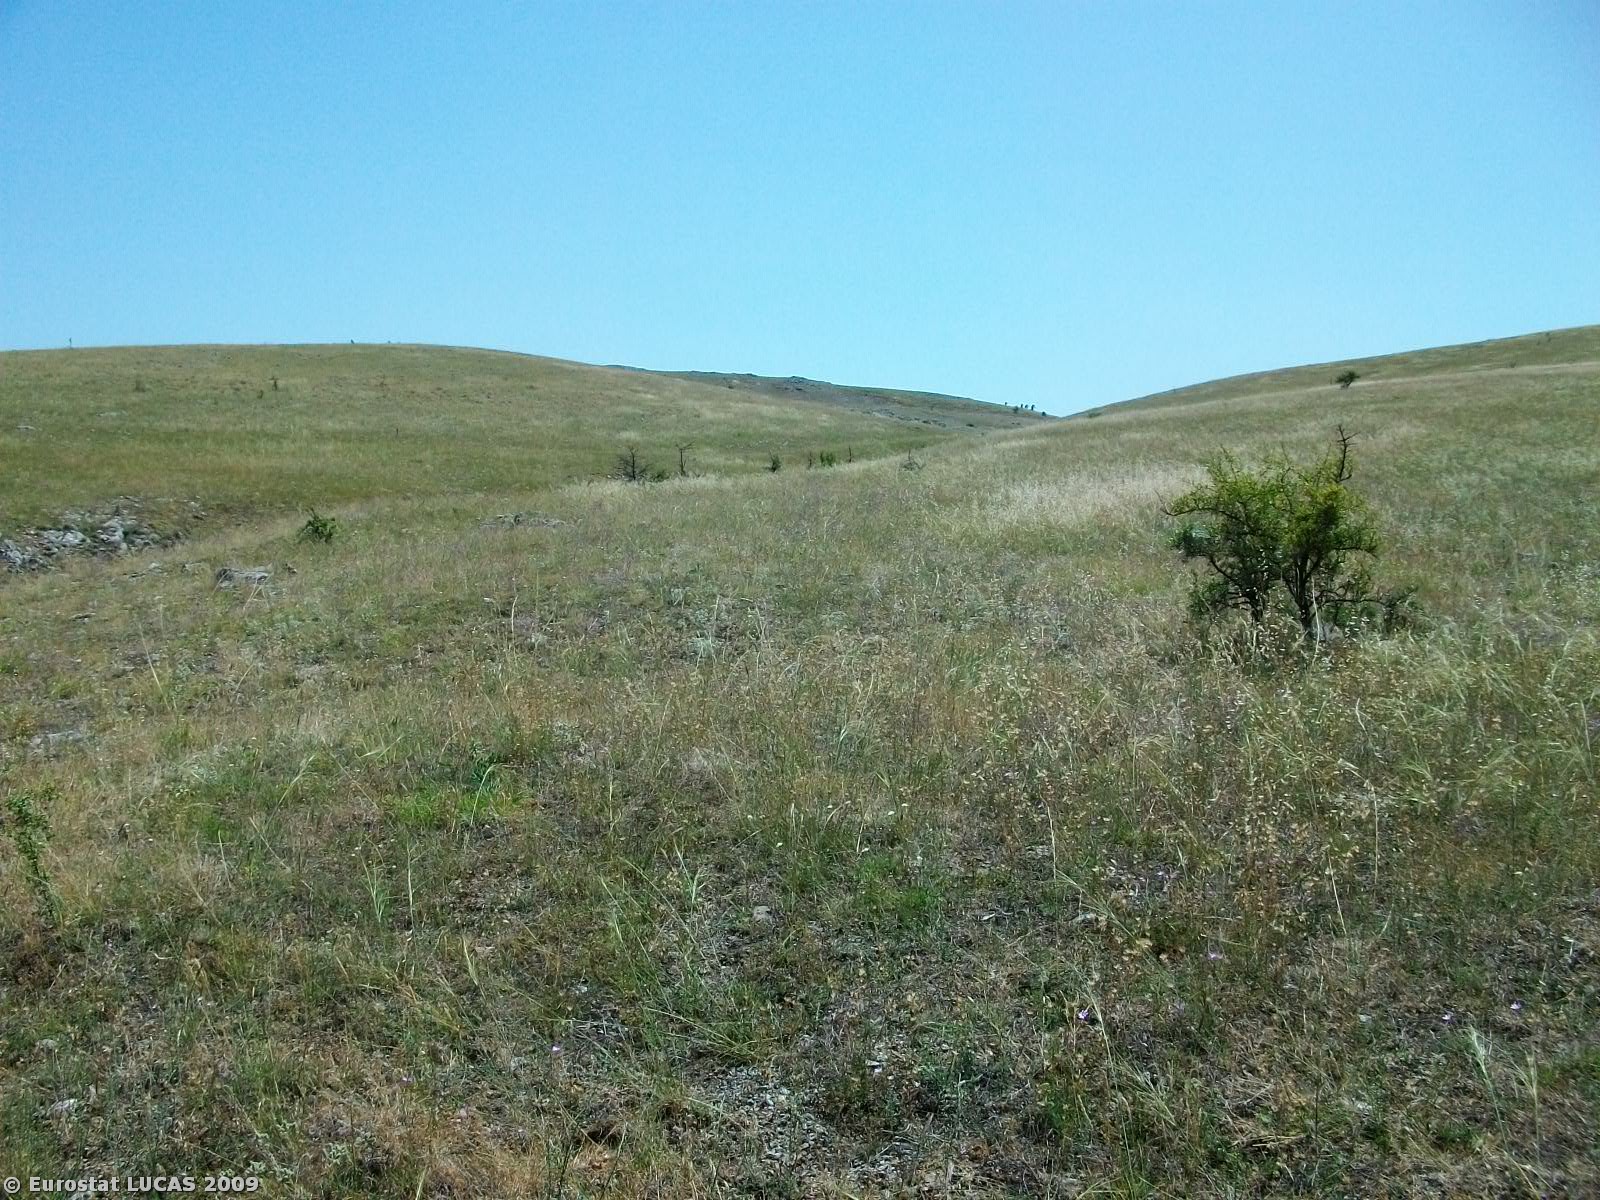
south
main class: Grassland
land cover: Grassland without tree/shrub cover
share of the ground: > 75 %
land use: Unused
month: July
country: GR
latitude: 40.3436
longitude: 21.7527
